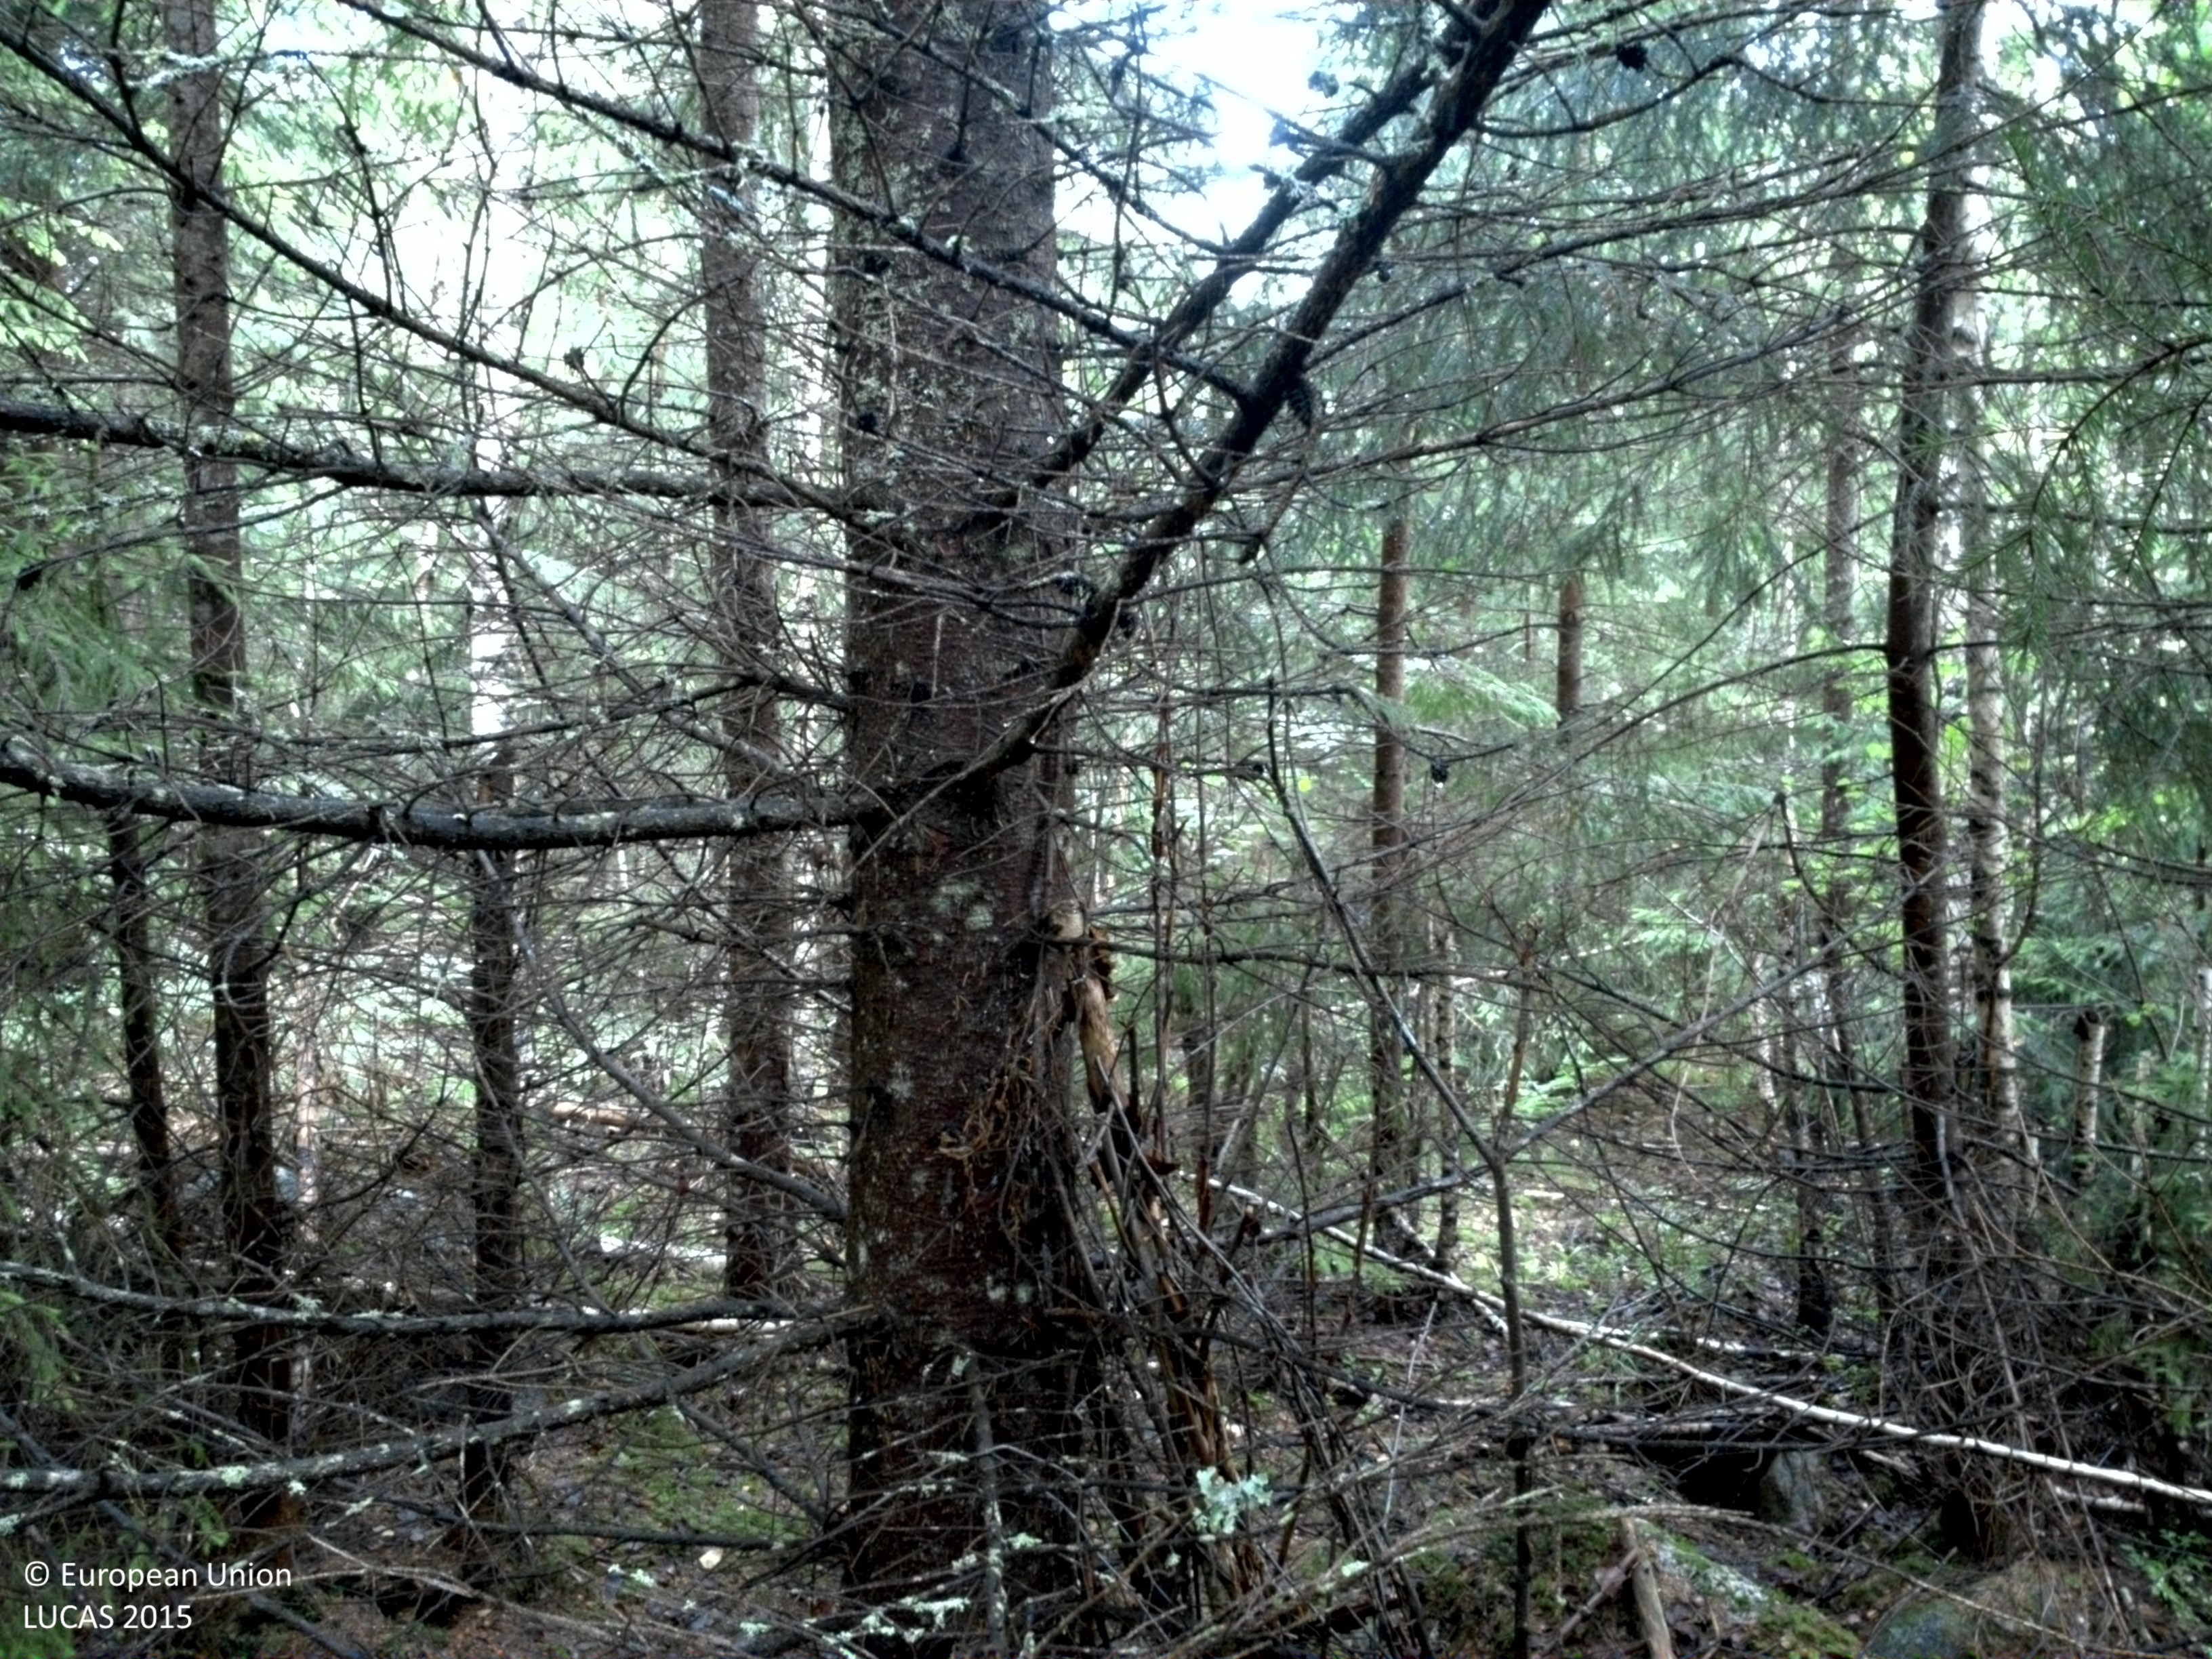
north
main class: Woodland
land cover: Spruce dominated coniferous woodland
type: boreal forest
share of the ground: > 75 %
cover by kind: coniferous forest trees 65 %, lichens and mosses 20 %, broadleaved forest trees 10 %, herbaceous plants 5 %
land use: Forestry
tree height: > 5 m
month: July
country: SE
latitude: 59.8955
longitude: 18.6679
